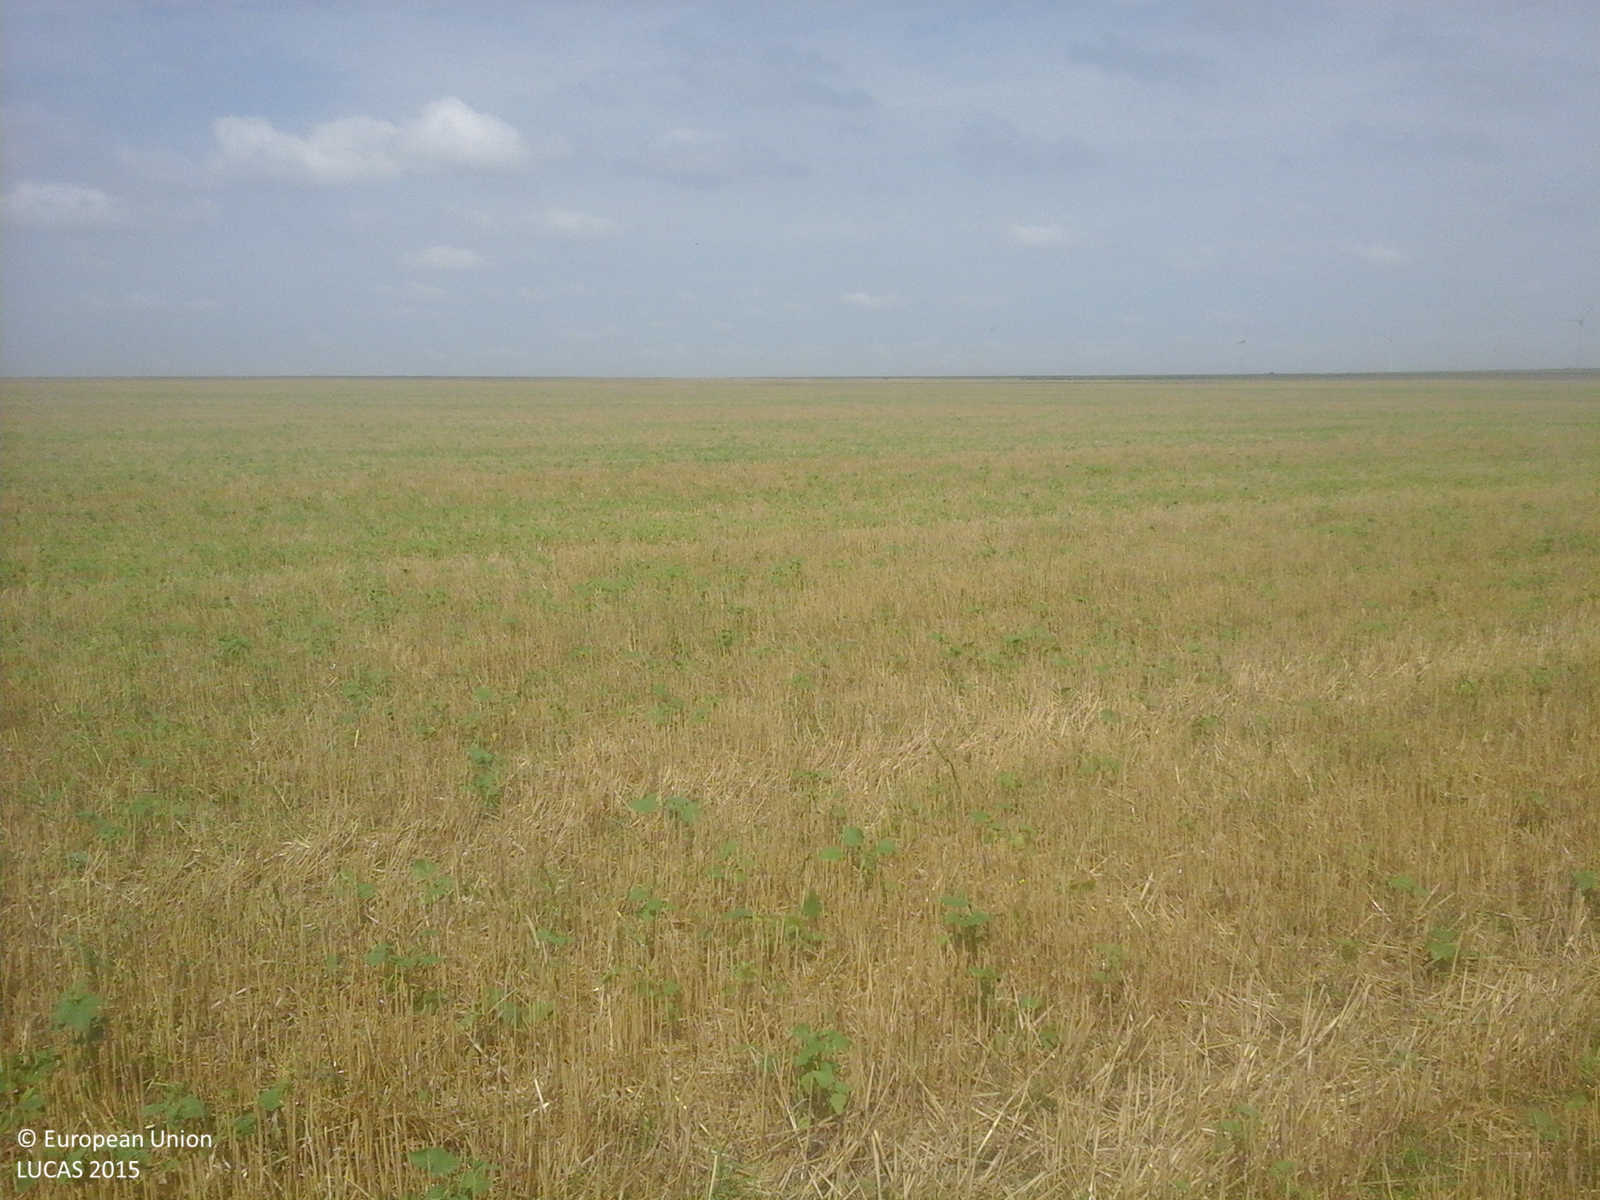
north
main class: Cropland
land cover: Common wheat
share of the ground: > 75 %
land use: Agriculture (excluding fallow land and kitchen gardens)
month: August
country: RO
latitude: 44.6724
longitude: 28.3479
